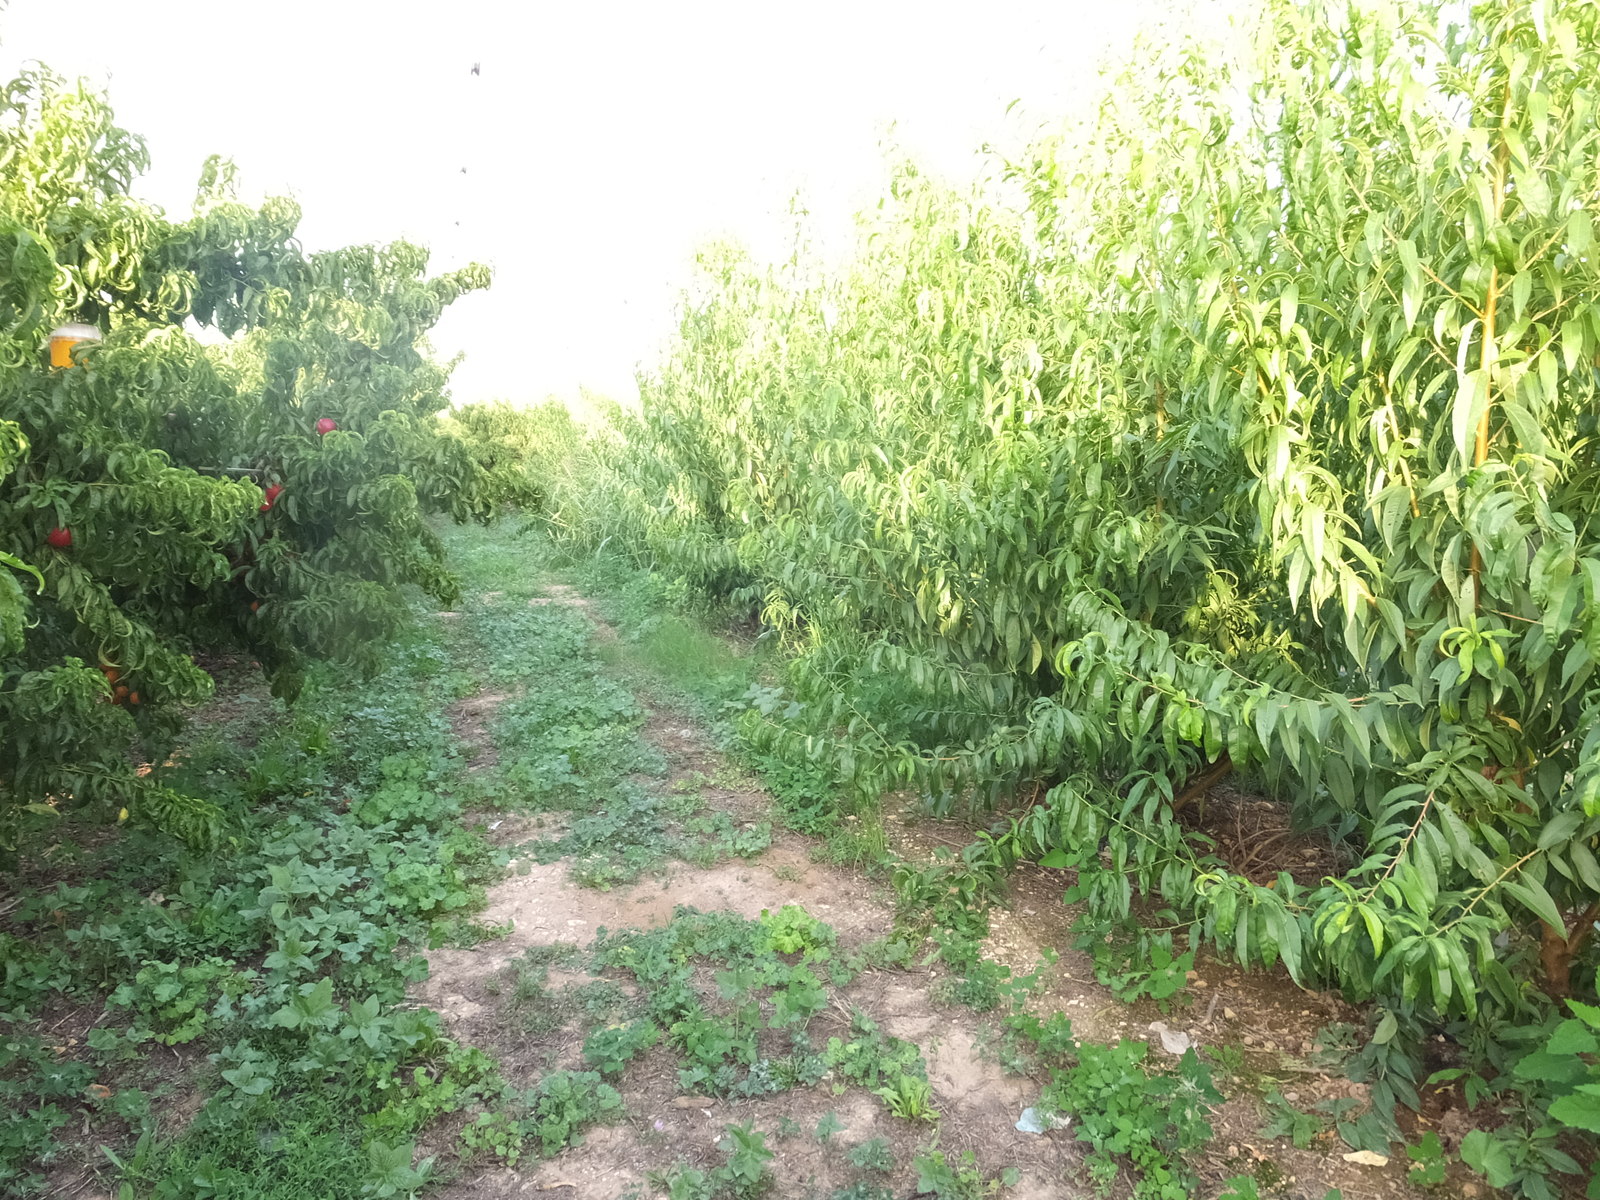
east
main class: Cropland
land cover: Other fruit trees and berries
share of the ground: > 75 %
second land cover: Spontaneously vegetated surfaces
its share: 10 - 25 %
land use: Agriculture (excluding fallow land and kitchen gardens)
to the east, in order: Other fruit trees and berries; Spontaneously vegetated surfaces; Tracks; Grassland without tree/shrub cover; Other fruit trees and berries; Tracks; Spontaneously vegetated surfaces; Electric lines; Spontaneously vegetated surfaces; Tracks
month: August
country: ES
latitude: 41.5995
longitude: 0.4246
